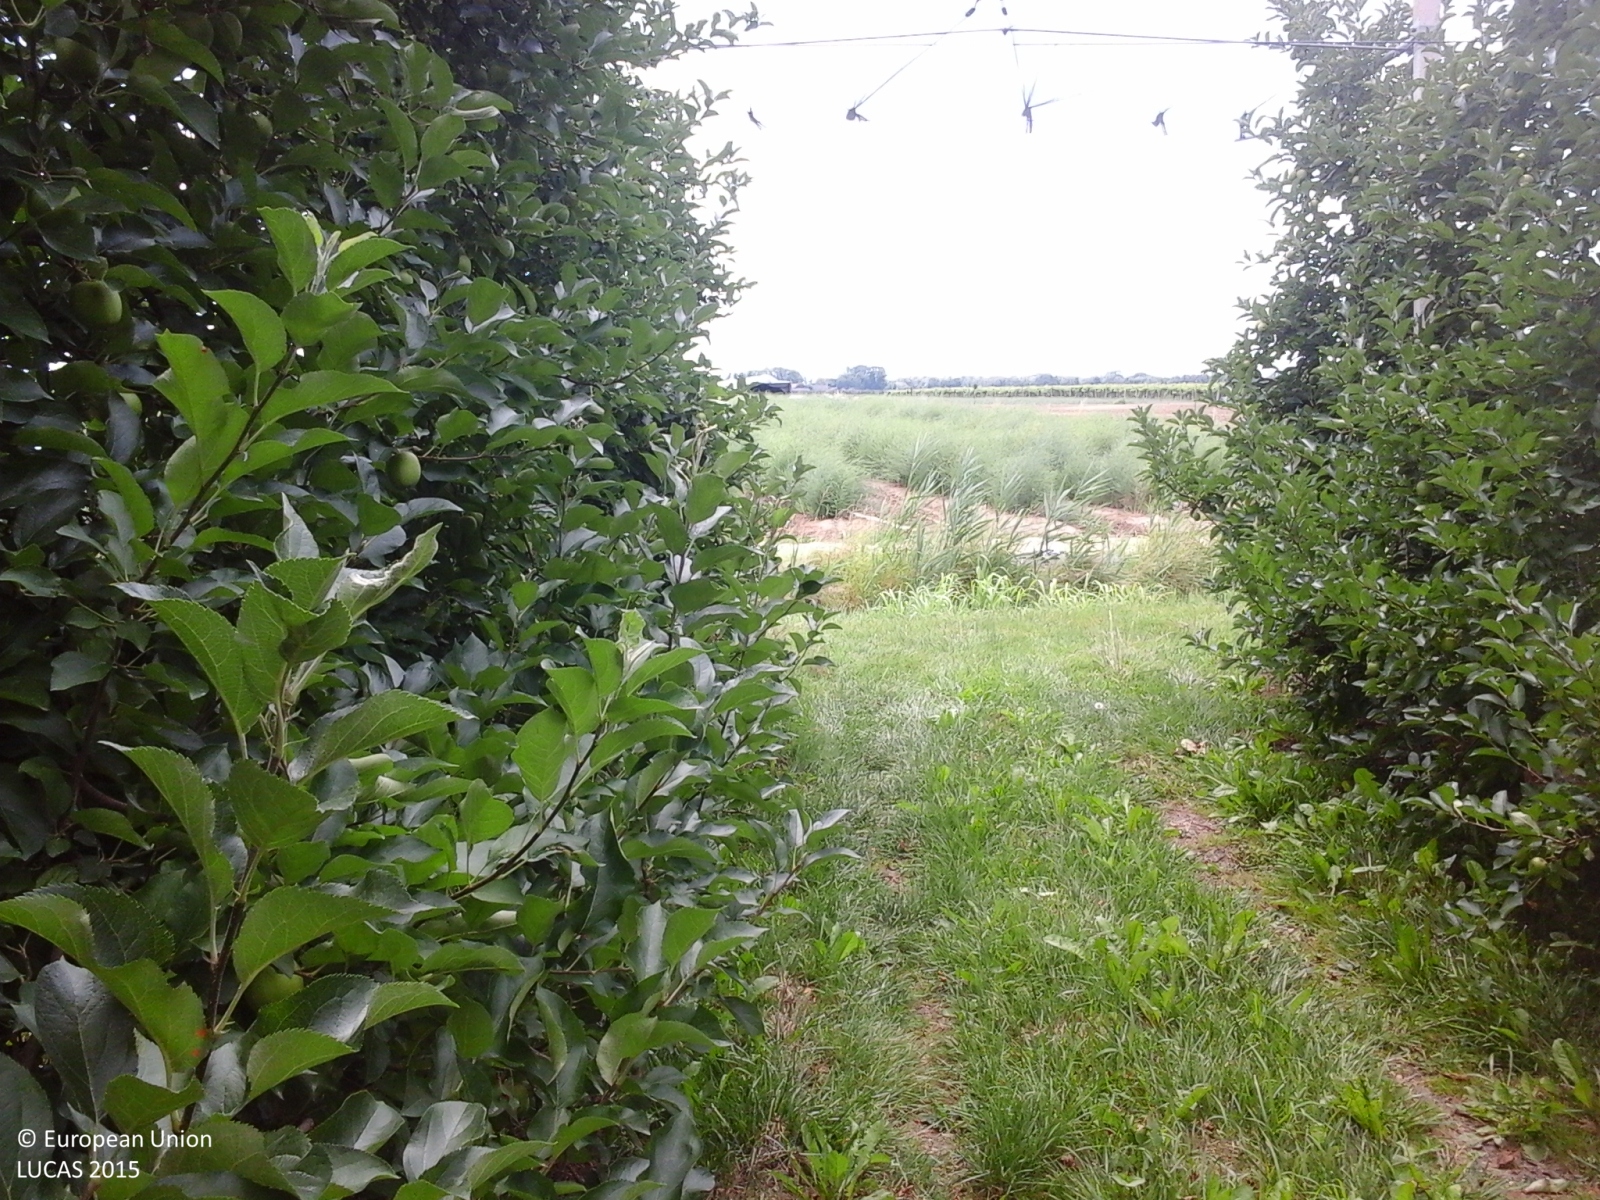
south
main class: Cropland
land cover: Apple fruit
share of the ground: 25 - 50 %
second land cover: Grassland without tree/shrub cover
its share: > 75 %
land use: Agriculture (excluding fallow land and kitchen gardens)
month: June
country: IT
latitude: 45.3896
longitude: 11.1858
